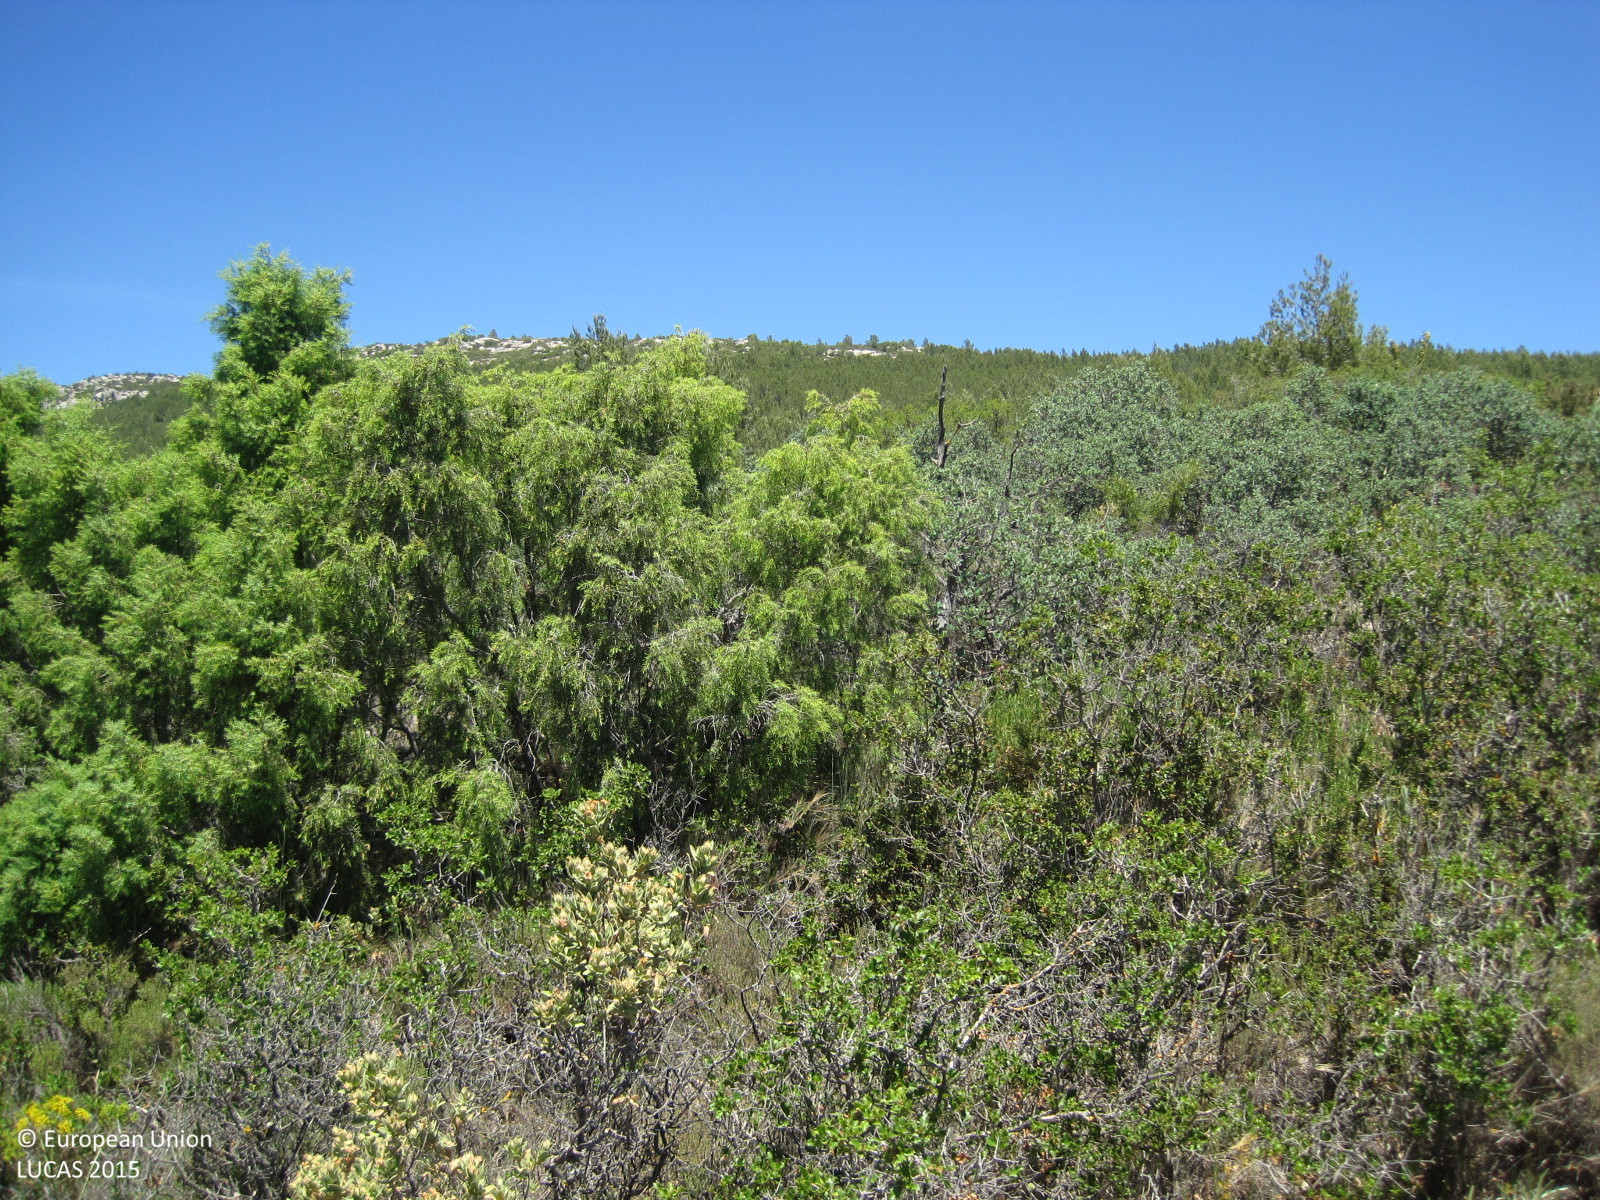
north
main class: Shrubland
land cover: Shrubland without tree cover
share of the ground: > 75 %
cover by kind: shrubs 95 %, consolidated bare surface 5 %
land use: Semi-natural and natural areas not in use
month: May
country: ES
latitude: 39.4254
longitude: -0.8607
